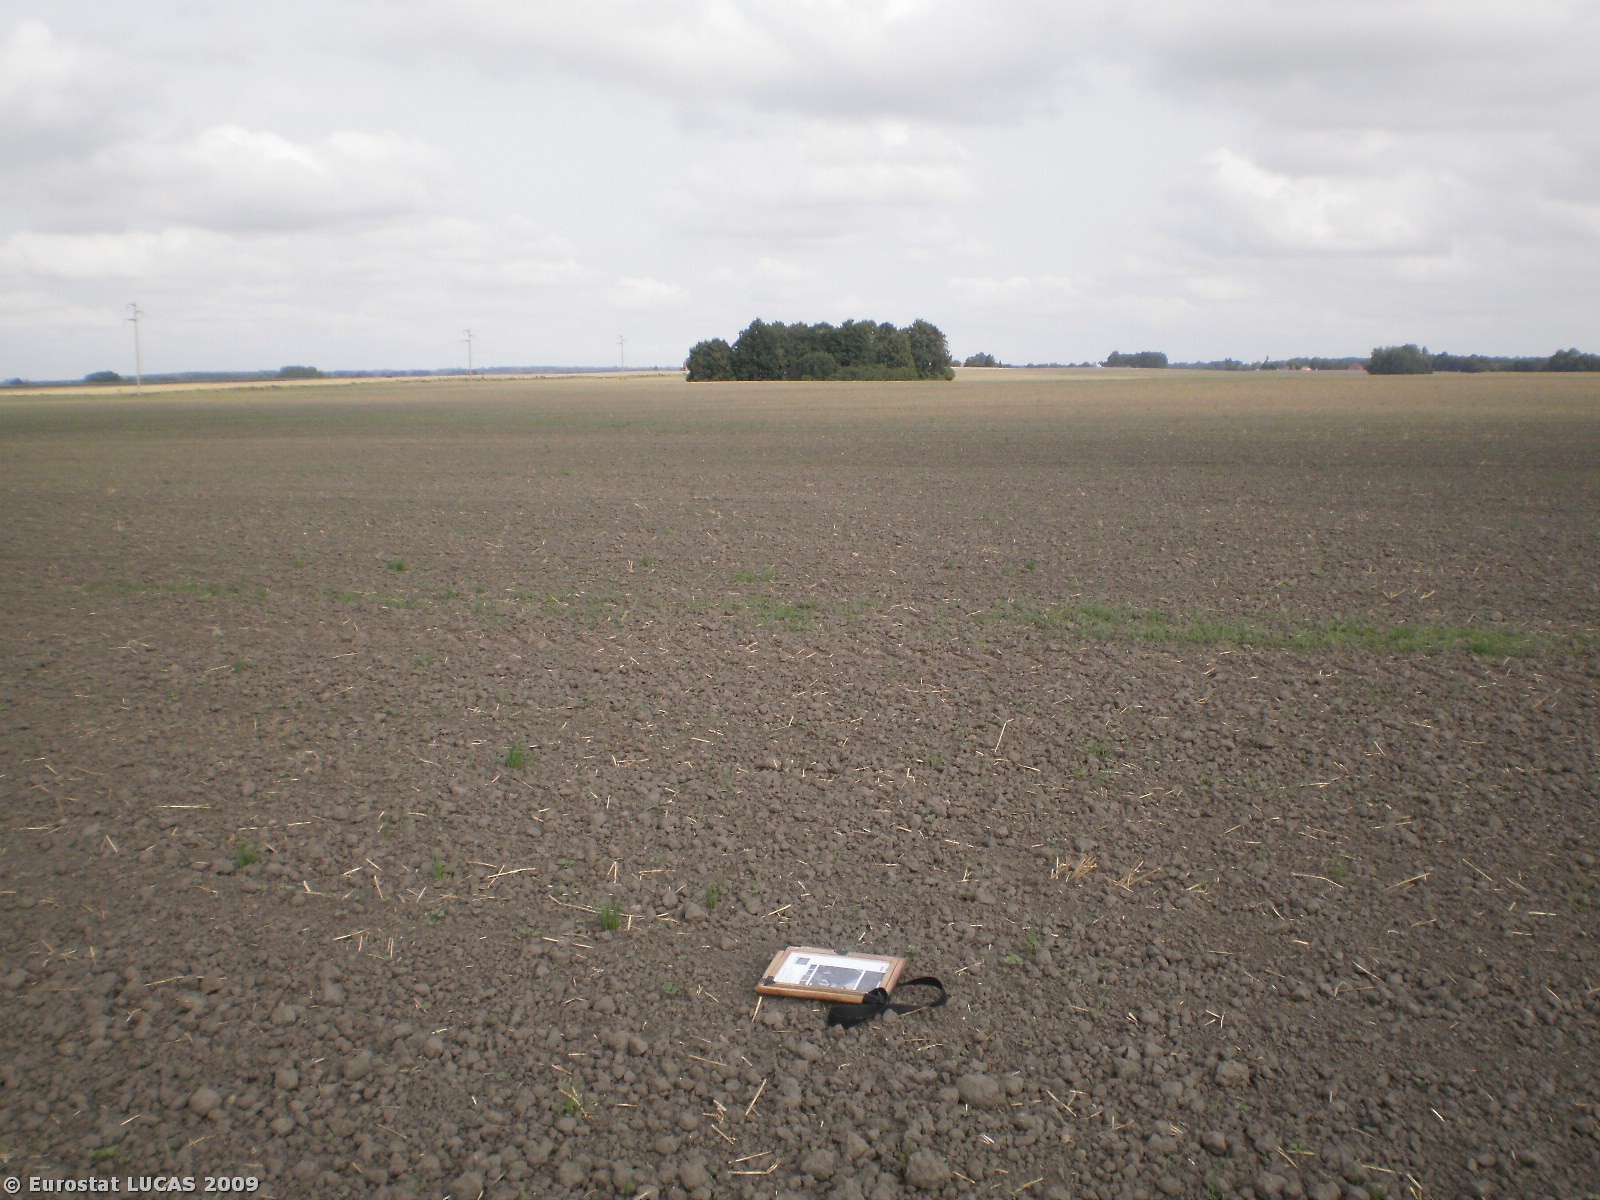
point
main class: Cropland
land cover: Common wheat
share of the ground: < 10 %
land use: Agriculture (excluding fallow land and kitchen gardens)
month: August
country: PL
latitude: 54.2192
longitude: 21.2565
